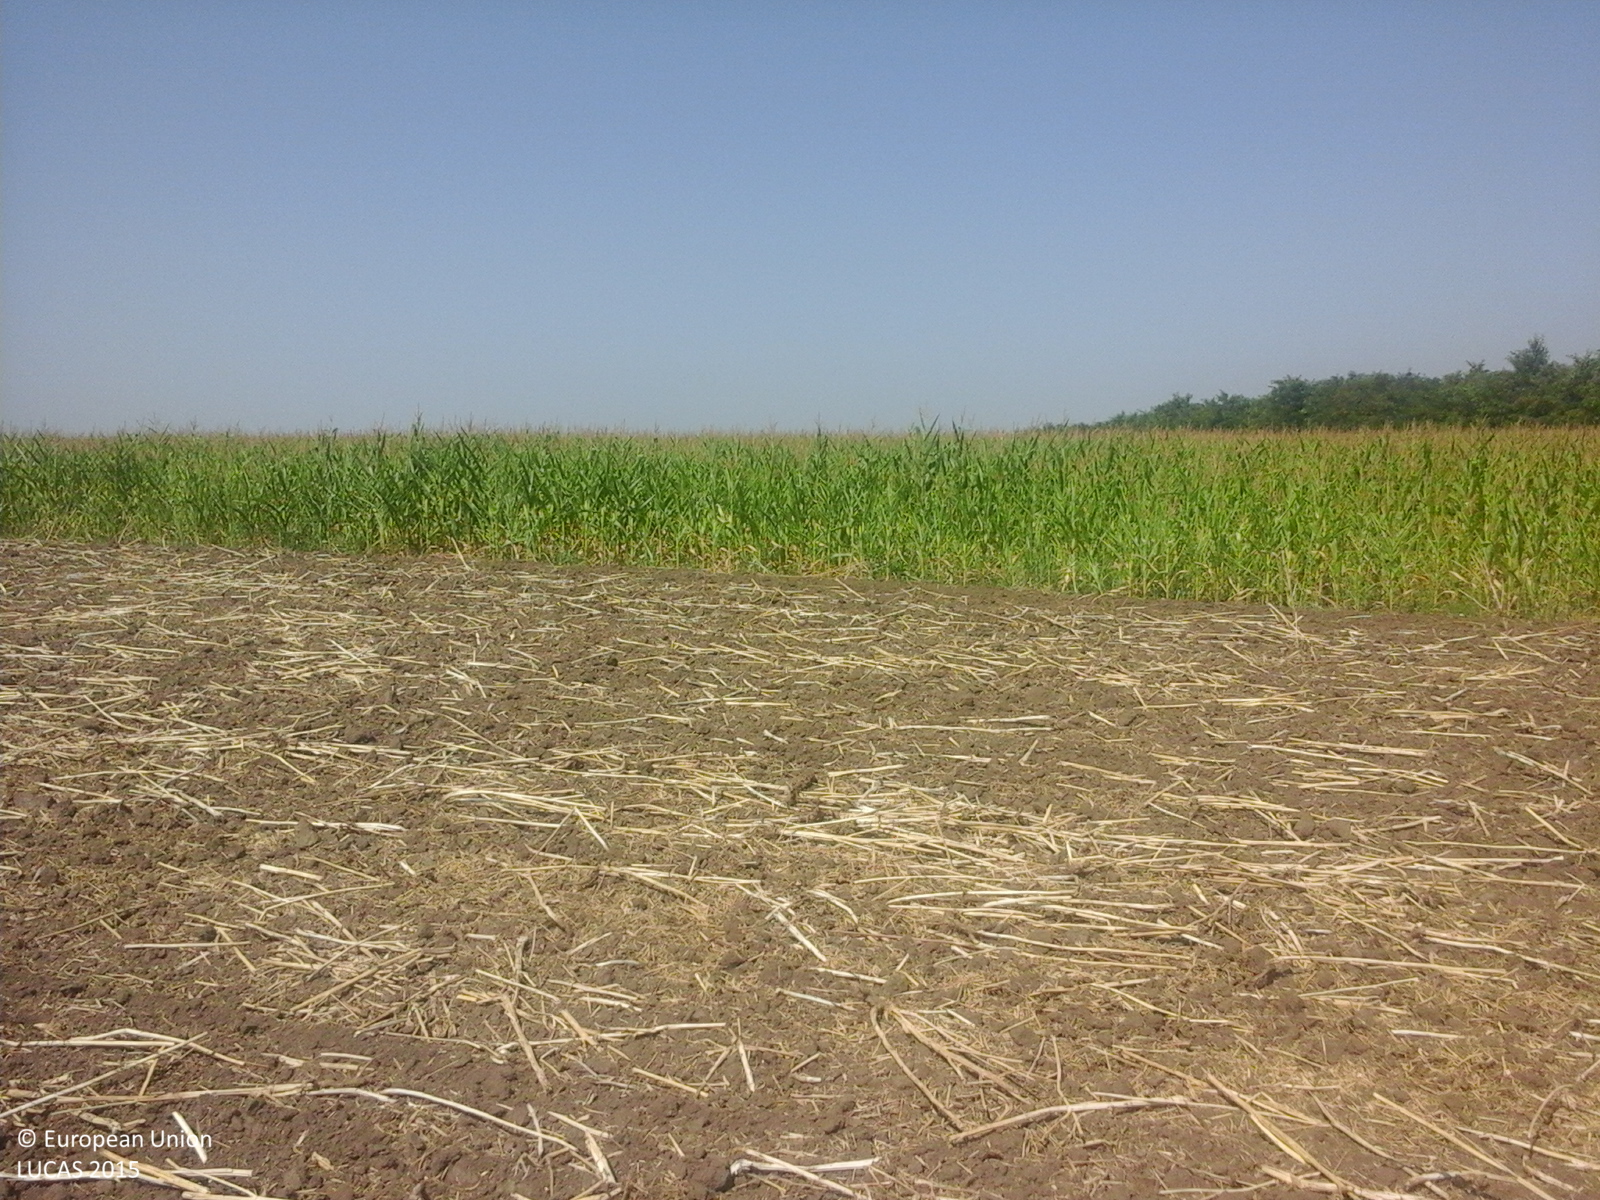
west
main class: Cropland
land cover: Rape and turnip rape
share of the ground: < 10 %
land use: Agriculture (excluding fallow land and kitchen gardens)
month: July
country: RO
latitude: 44.3397
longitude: 27.0743
